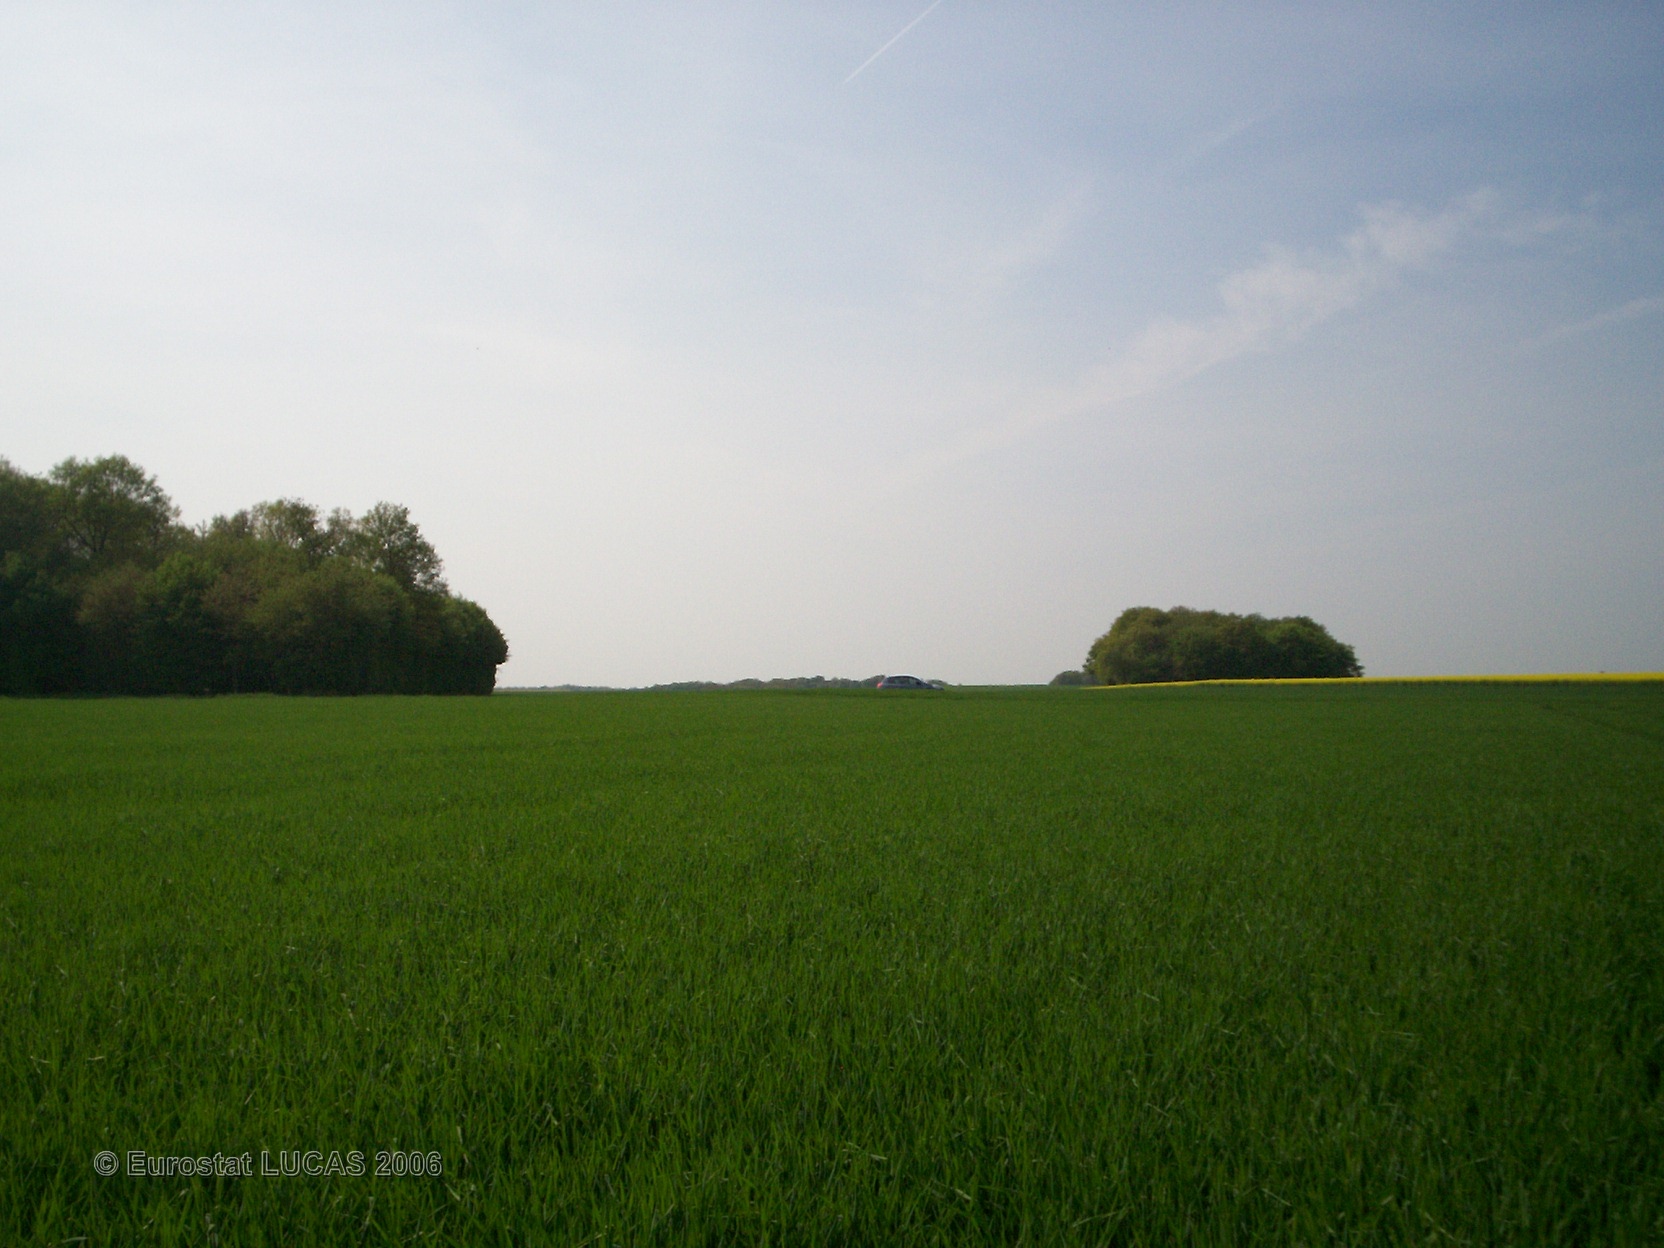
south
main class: Cropland
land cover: Barley
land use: Agriculture (excluding fallow land and kitchen gardens)
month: May
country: FR
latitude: 48.0698
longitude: 2.9467
